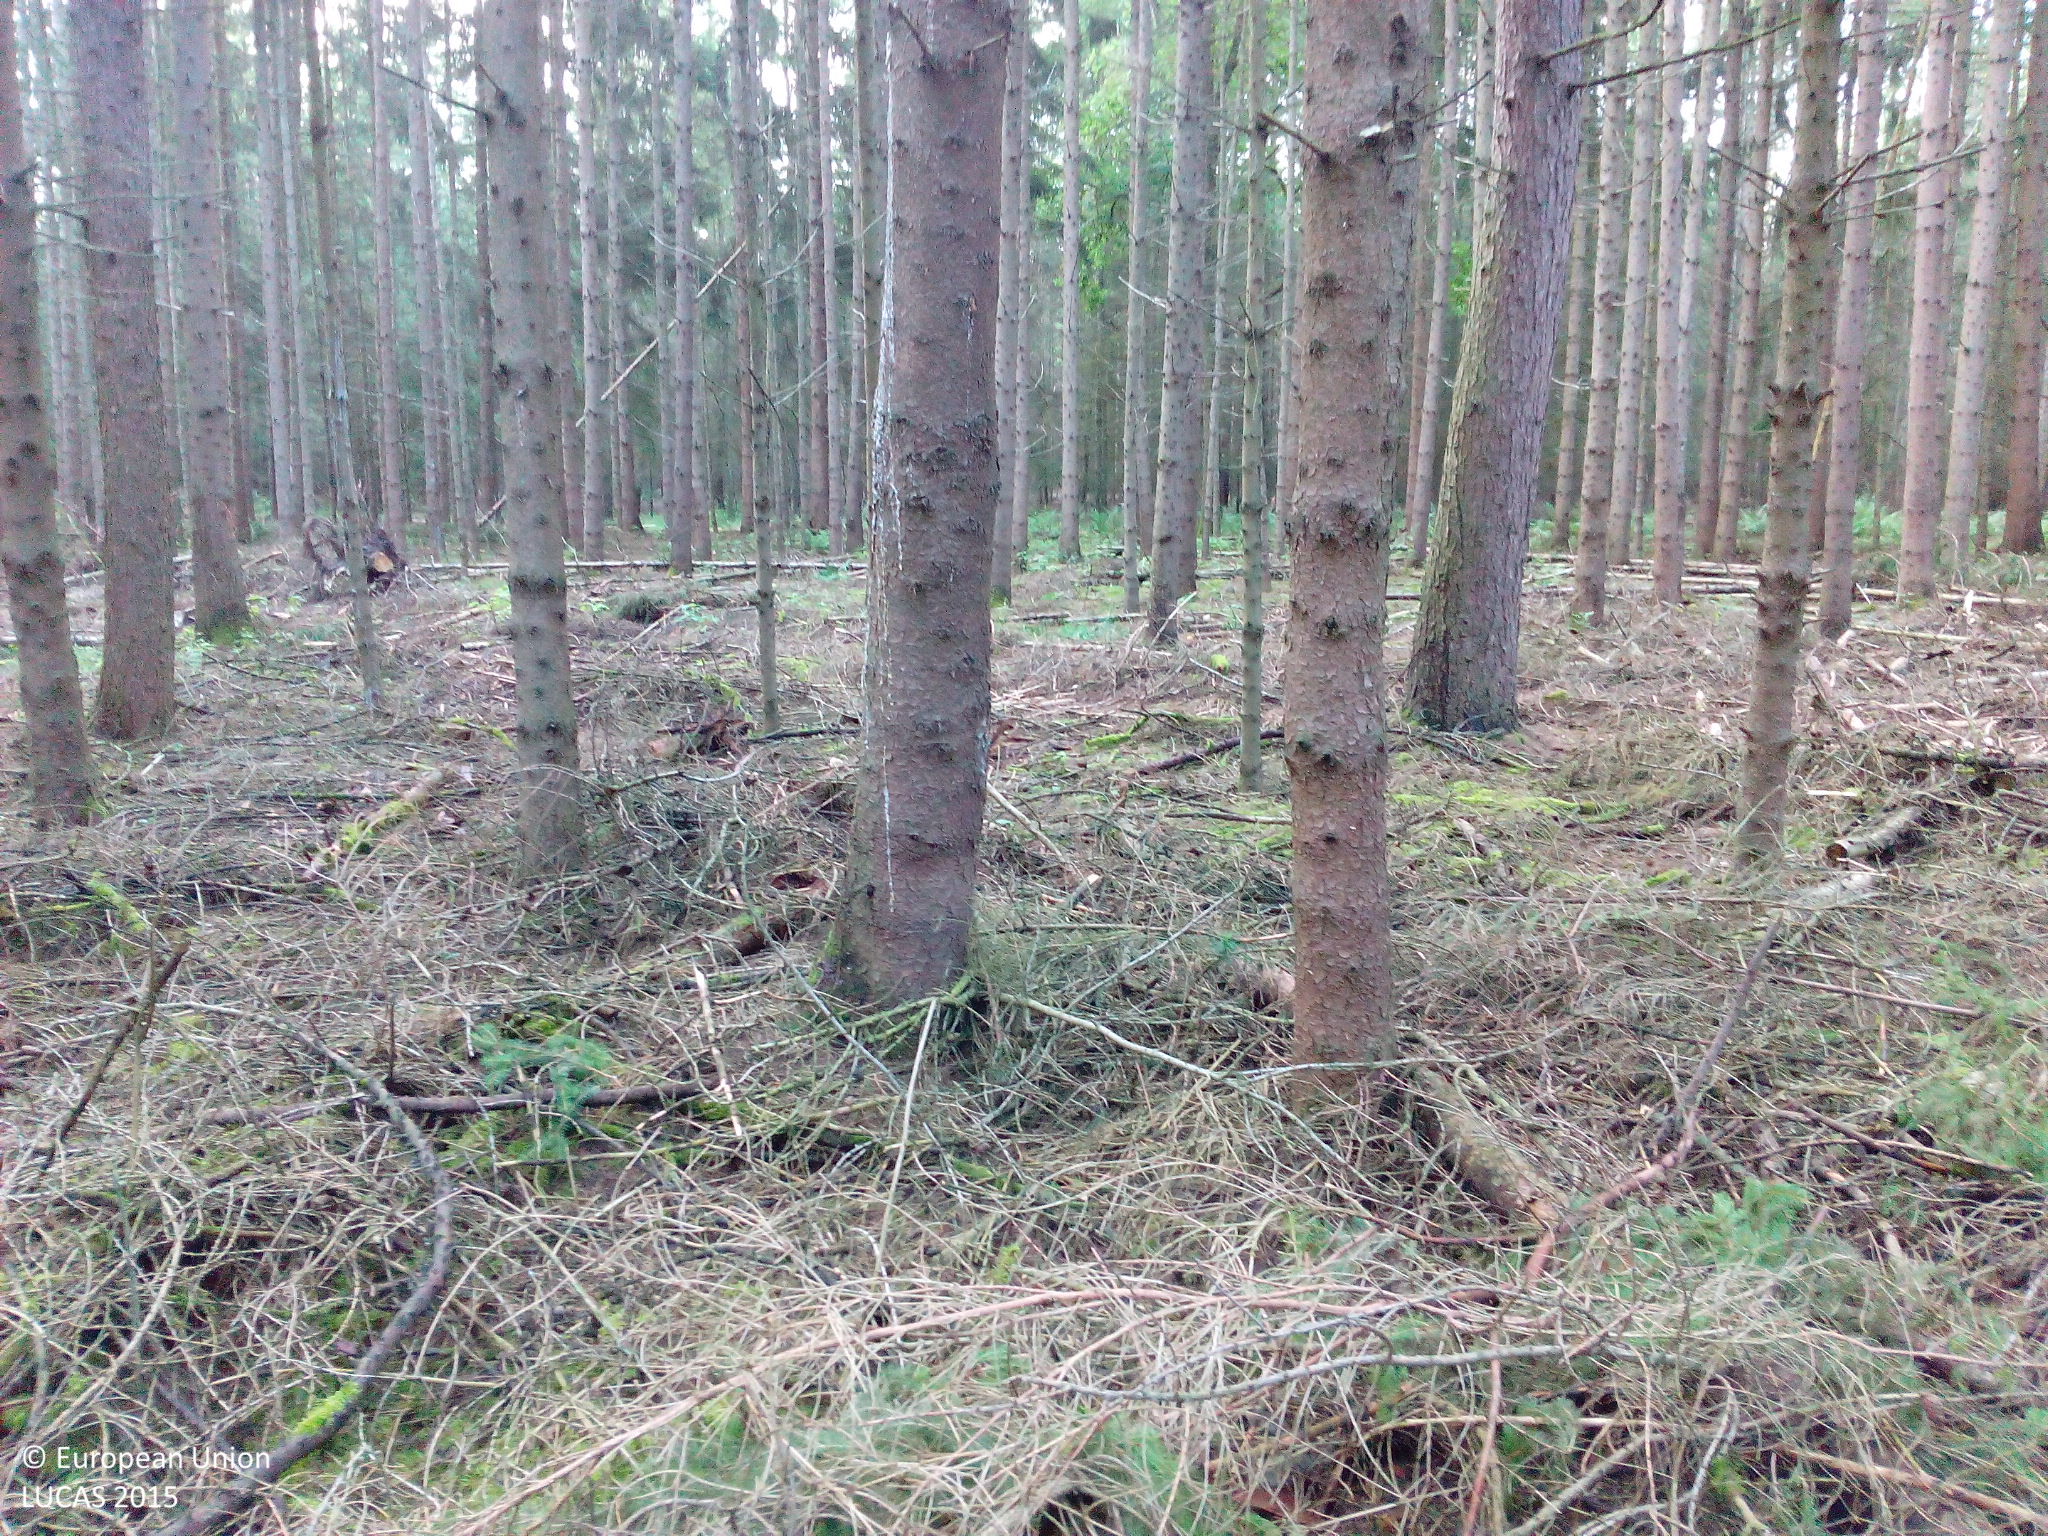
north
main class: Woodland
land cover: Other coniferous woodland
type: hemiboreal forest and nemoral coniferous forest and mixed broadleaved-coniferous forest
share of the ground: 50 - 75 %
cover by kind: coniferous forest trees 70 %, lichens and mosses 25 %, herbaceous plants 5 %
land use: Forestry
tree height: > 5 m
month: July
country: DE
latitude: 53.3461
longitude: 13.6802
